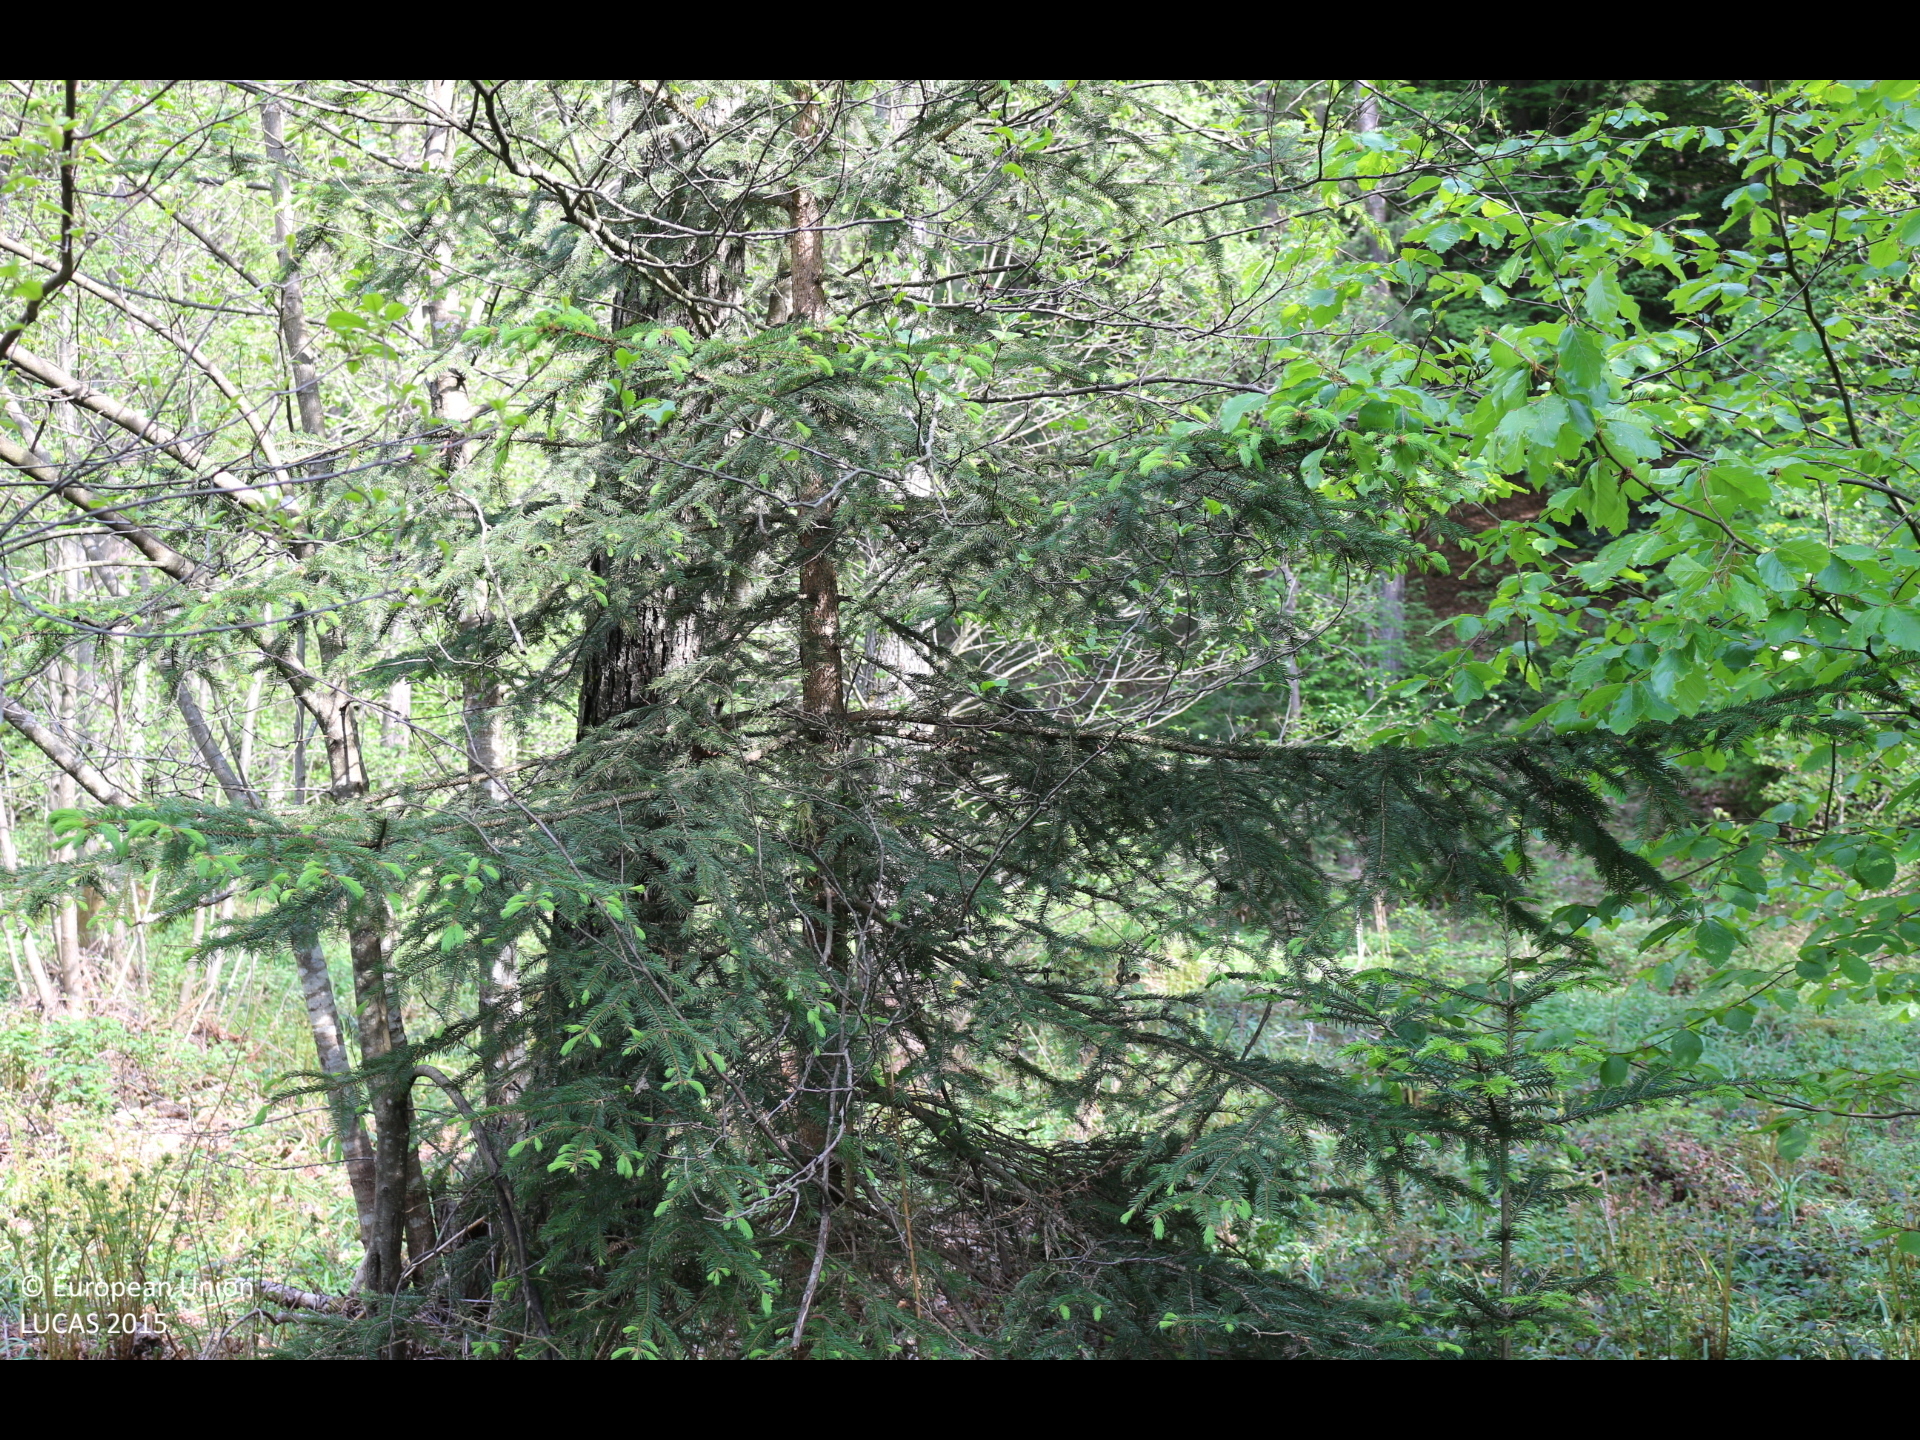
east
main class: Woodland
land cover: Spruce dominated mixed woodland
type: mountainous beech forest
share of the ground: > 75 %
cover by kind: broadleaved forest trees 50 %, coniferous forest trees 40 %, shrubs 10 %
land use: Forestry
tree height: > 5 m
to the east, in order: Spruce dominated mixed woodland; Spruce dominated coniferous woodland; Tracks; Spruce dominated coniferous woodland; Spruce dominated mixed woodland; Tracks; Spruce dominated coniferous woodland; Spruce dominated mixed woodland; Tracks; Spruce dominated mixed woodland; Grassland without tree/shrub cover
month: May
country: AT
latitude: 46.6468
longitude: 14.2176
